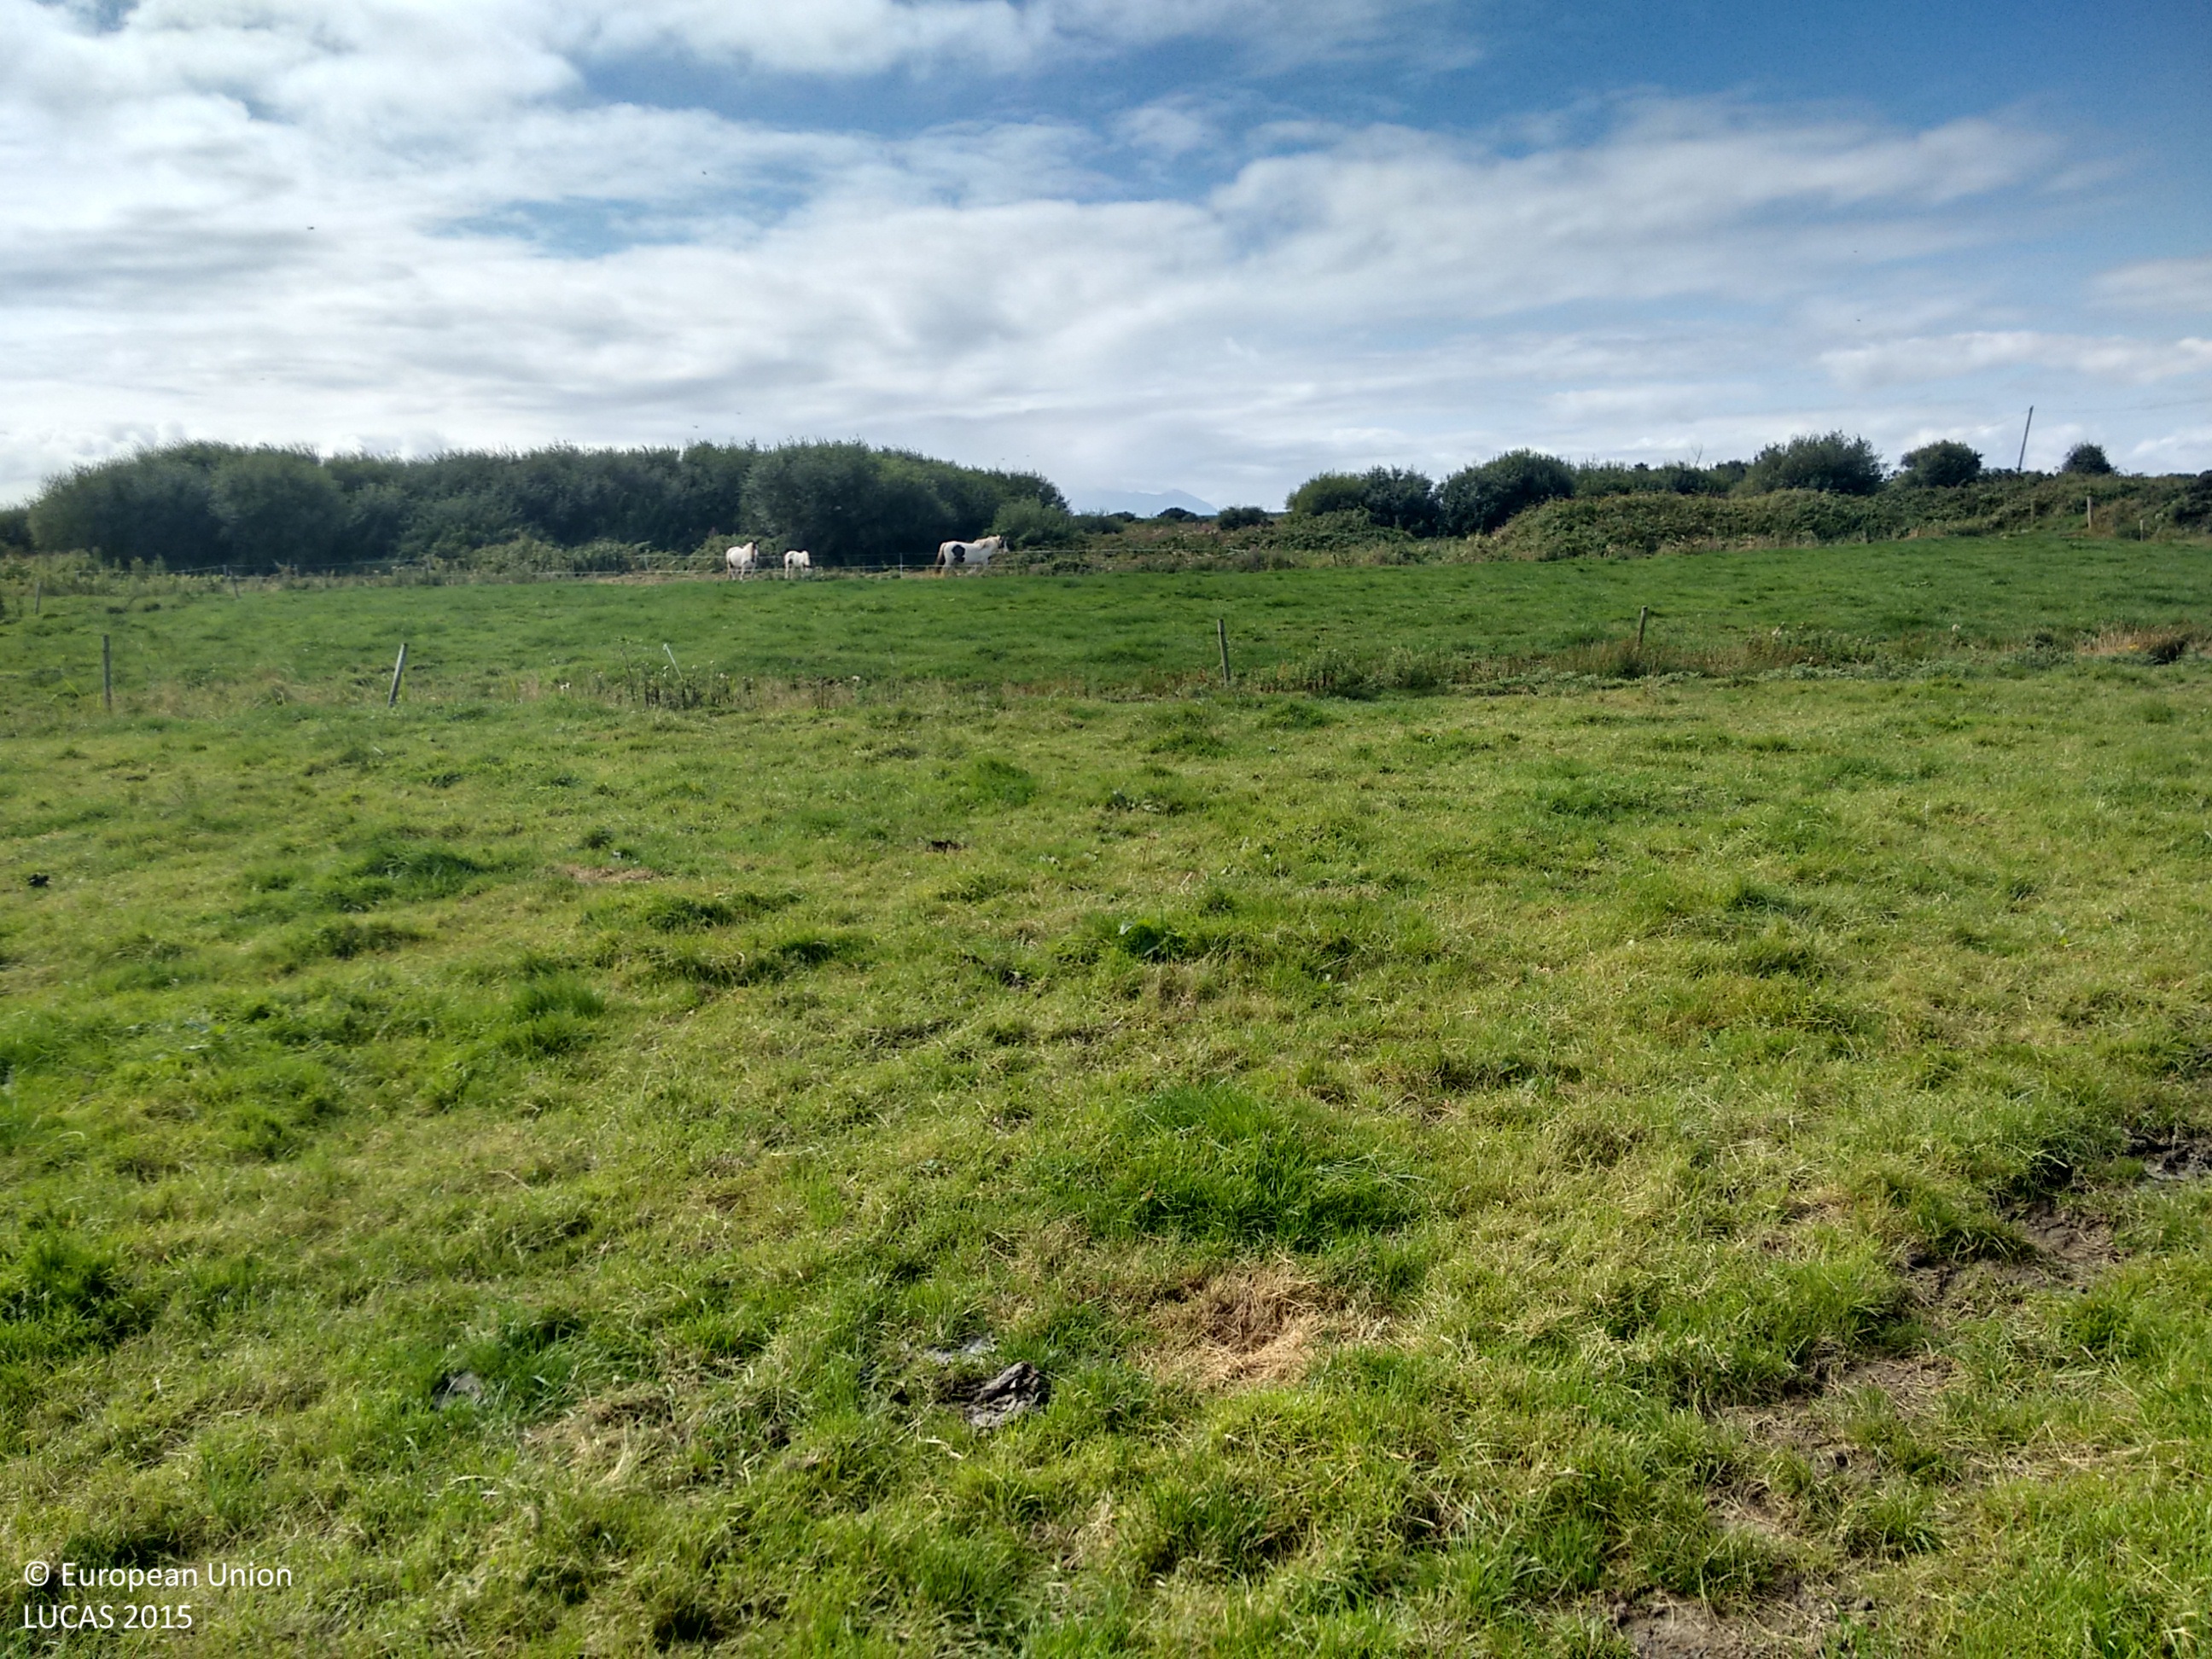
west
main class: Grassland
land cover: Grassland without tree/shrub cover
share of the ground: > 75 %
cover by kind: herbaceous plants 100 %
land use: Agriculture (excluding fallow land and kitchen gardens)
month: September
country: IE
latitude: 52.3950
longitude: -9.7752
